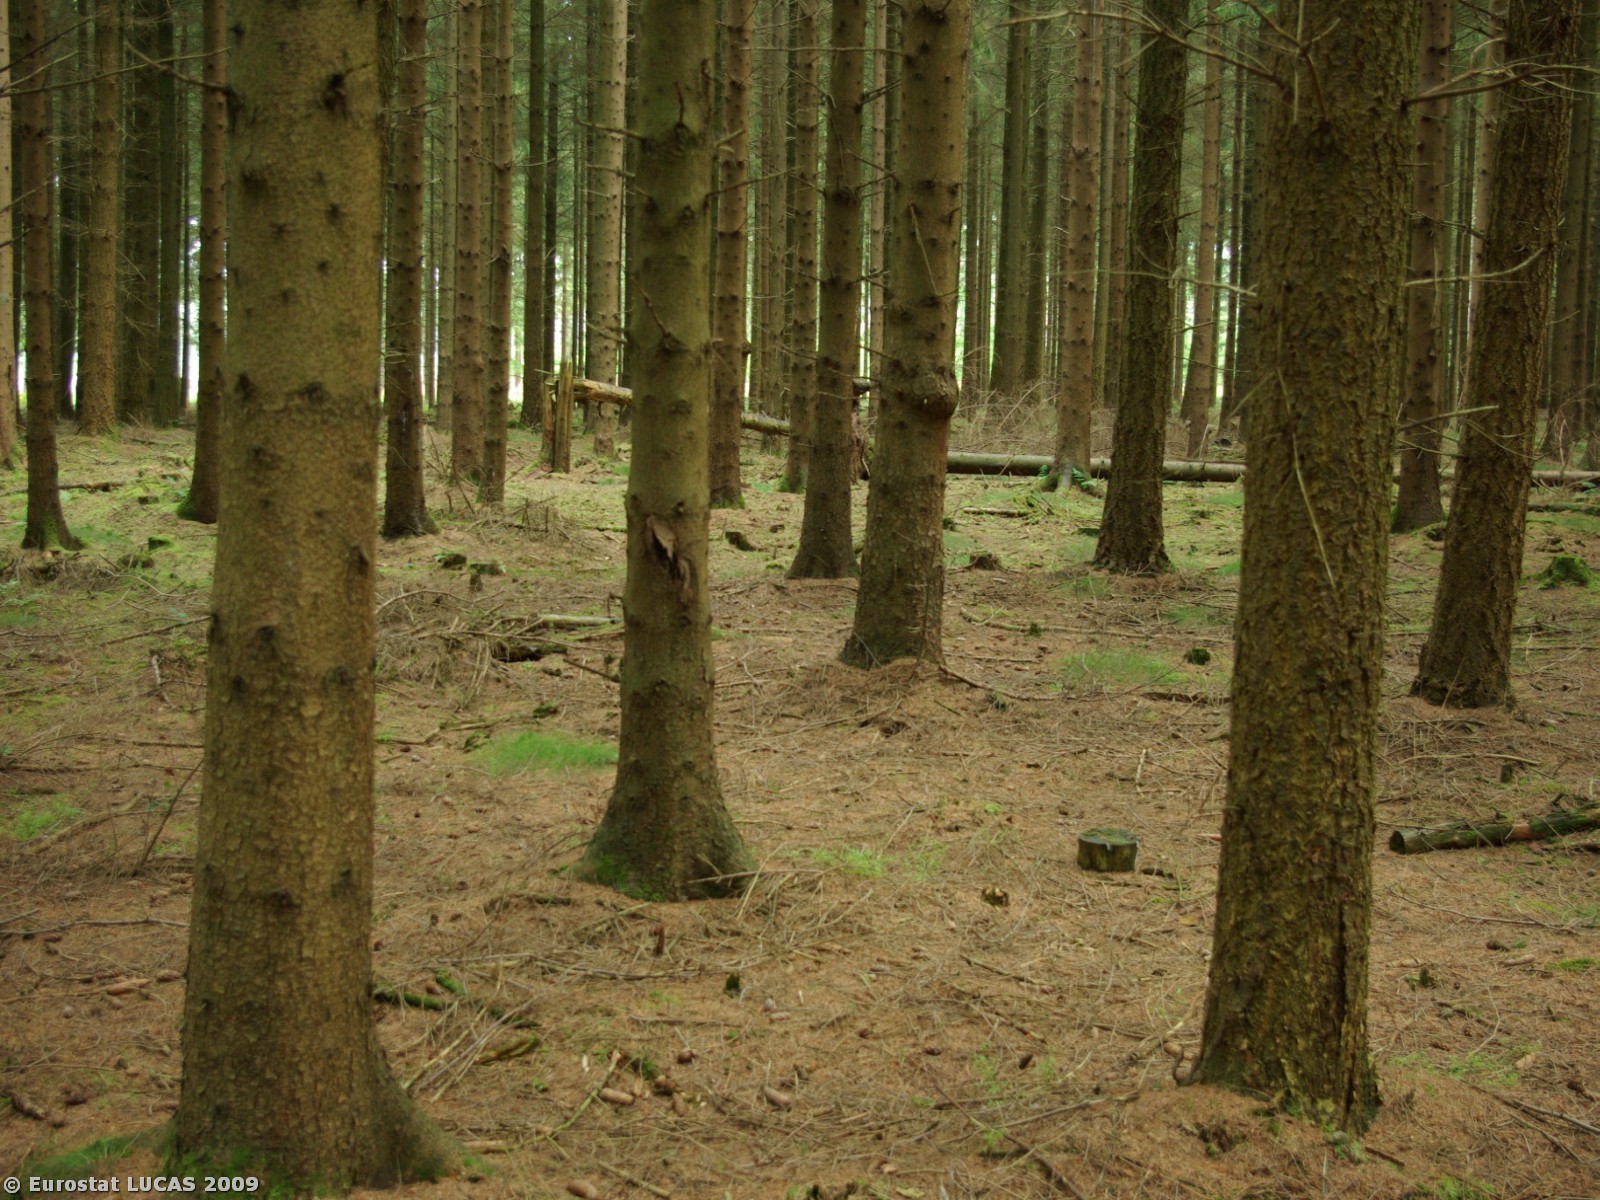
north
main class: Woodland
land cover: Coniferous woodland
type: hemiboreal forest and nemoral coniferous forest and mixed broadleaved-coniferous forest
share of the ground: > 75 %
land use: Forestry
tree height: > 5 m
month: July
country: DK
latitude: 54.8198
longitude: 9.3002
